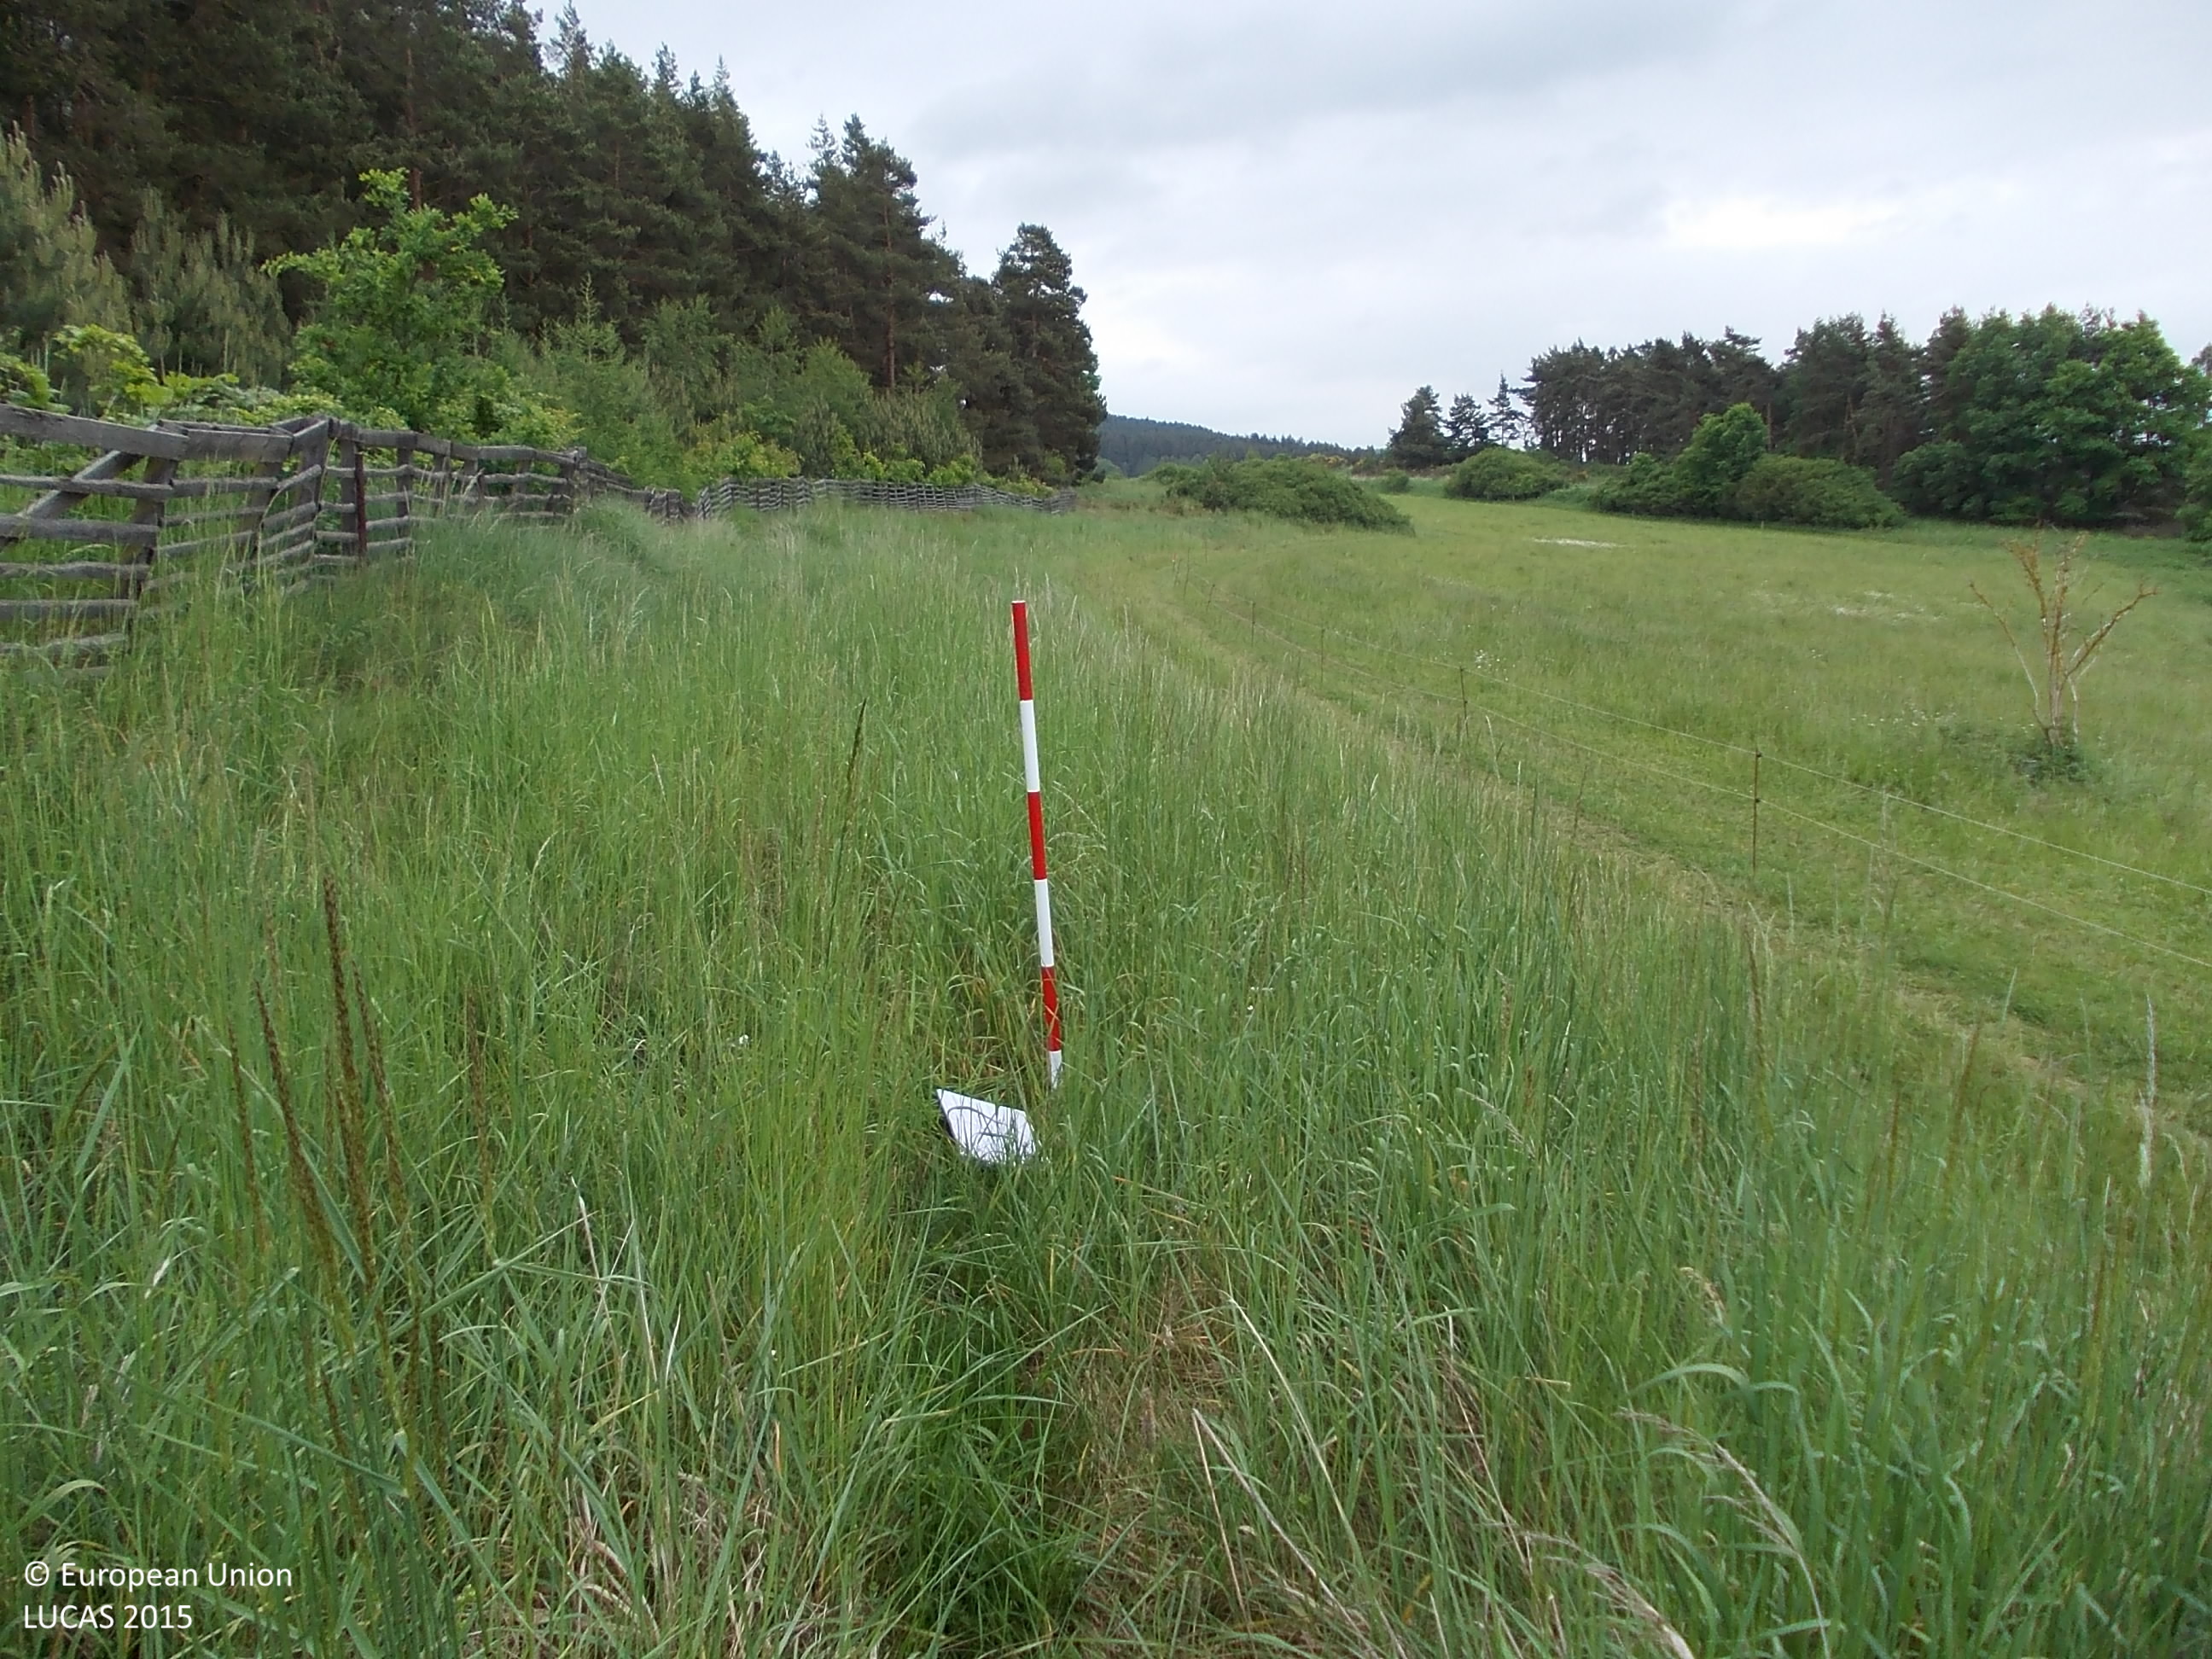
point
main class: Grassland
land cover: Grassland without tree/shrub cover
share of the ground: > 75 %
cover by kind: herbaceous plants 100 %
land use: Semi-natural and natural areas not in use
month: May
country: CZ
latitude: 49.3652
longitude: 13.7872
